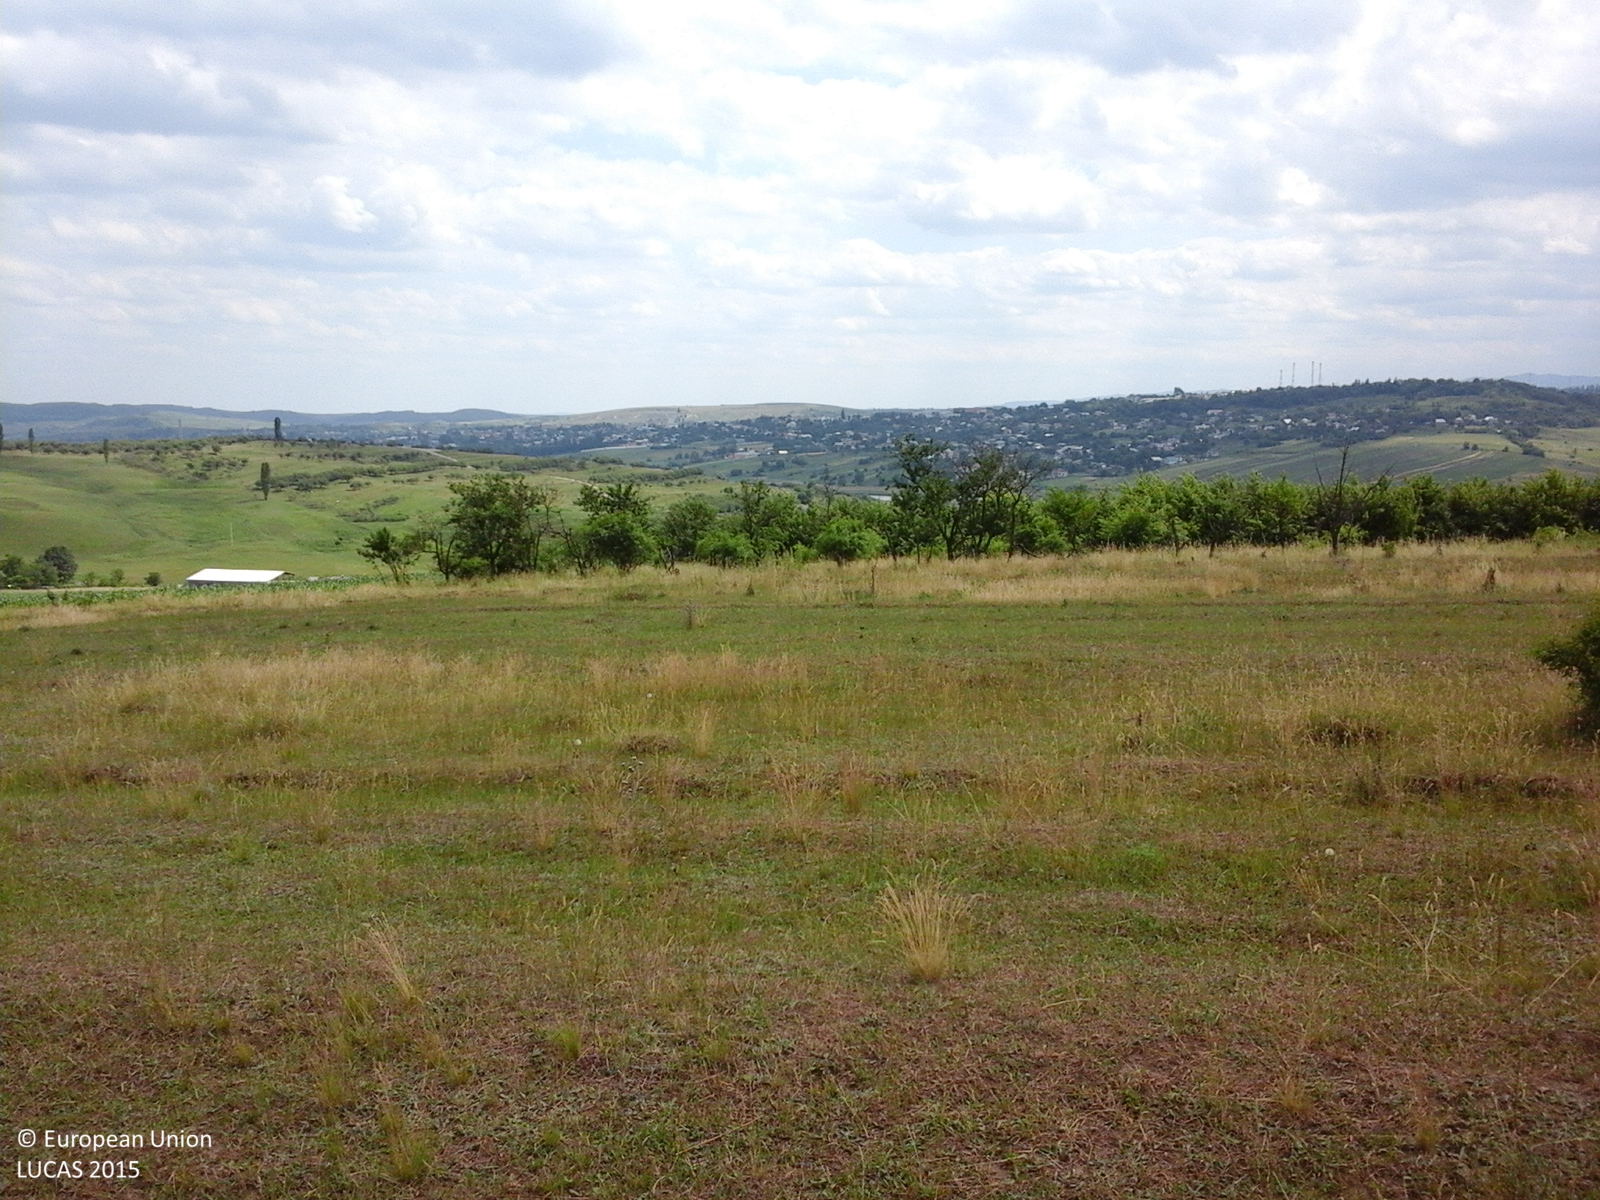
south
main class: Cropland
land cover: Apple fruit
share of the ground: 10 - 25 %
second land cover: Grassland without tree/shrub cover
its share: 50 - 75 %
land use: Agriculture (excluding fallow land and kitchen gardens)
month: June
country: RO
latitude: 47.4964
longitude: 26.2911
